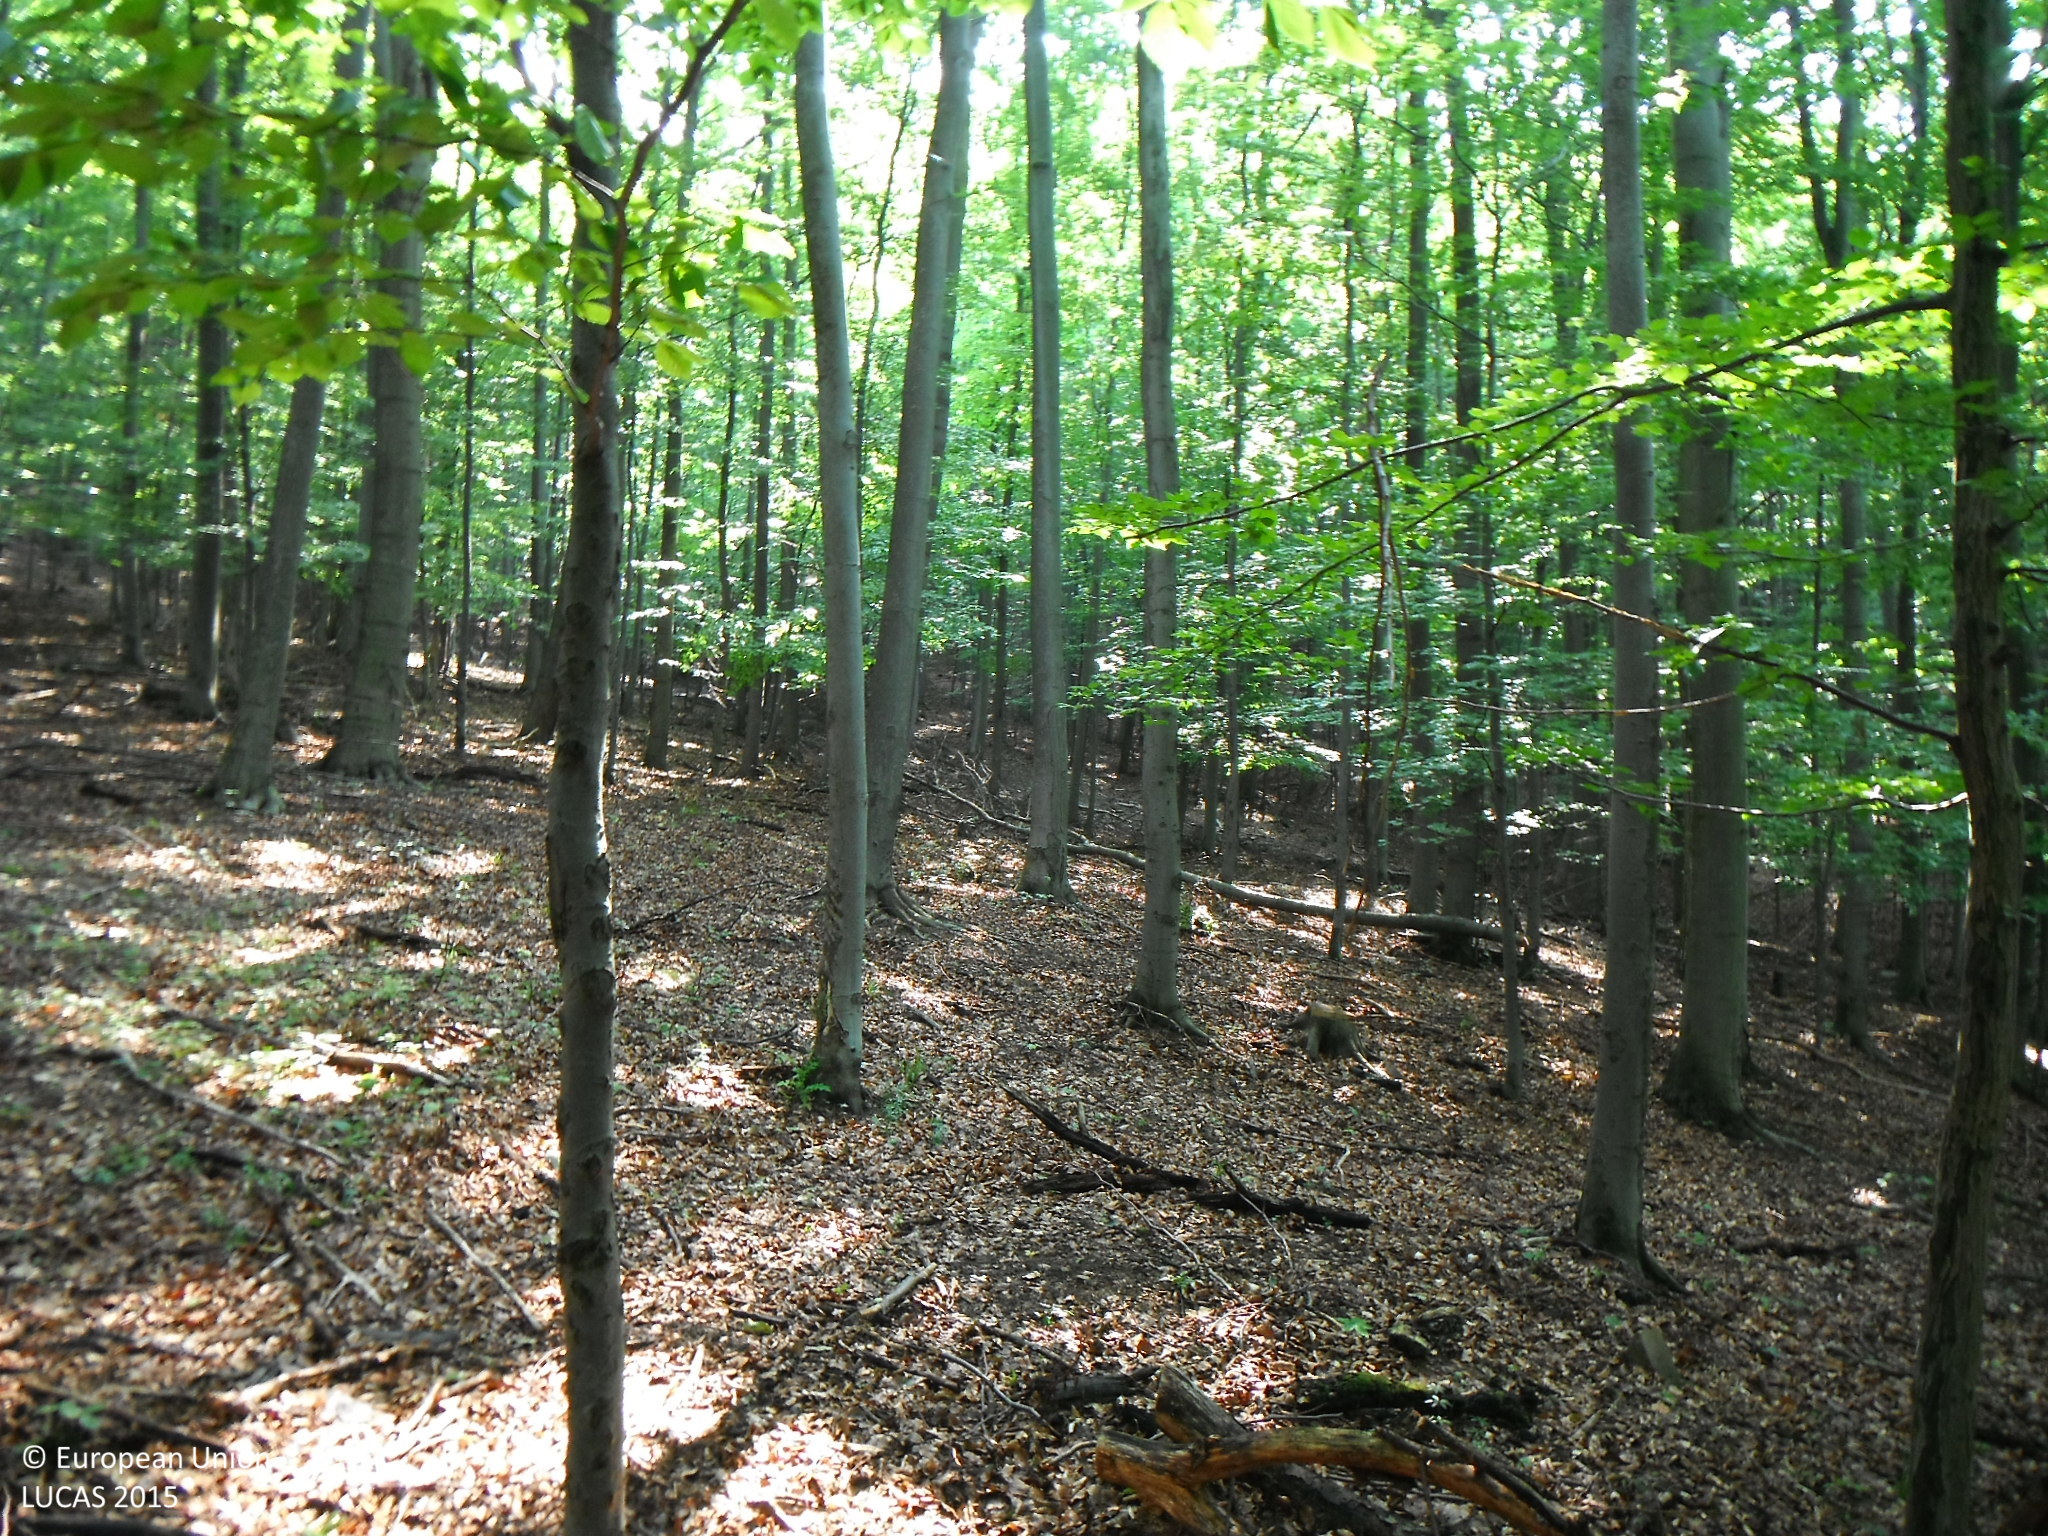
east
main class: Woodland
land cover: Broadleaved woodland
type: beech forest
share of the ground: > 75 %
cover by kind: broadleaved forest trees 95 %, herbaceous plants 5 %
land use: Forestry
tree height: > 5 m
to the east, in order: Broadleaved woodland; Tracks; Broadleaved woodland; Ditches and canals; Broadleaved woodland; Tracks; Broadleaved woodland
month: July
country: SK
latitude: 49.3870
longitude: 21.2738
